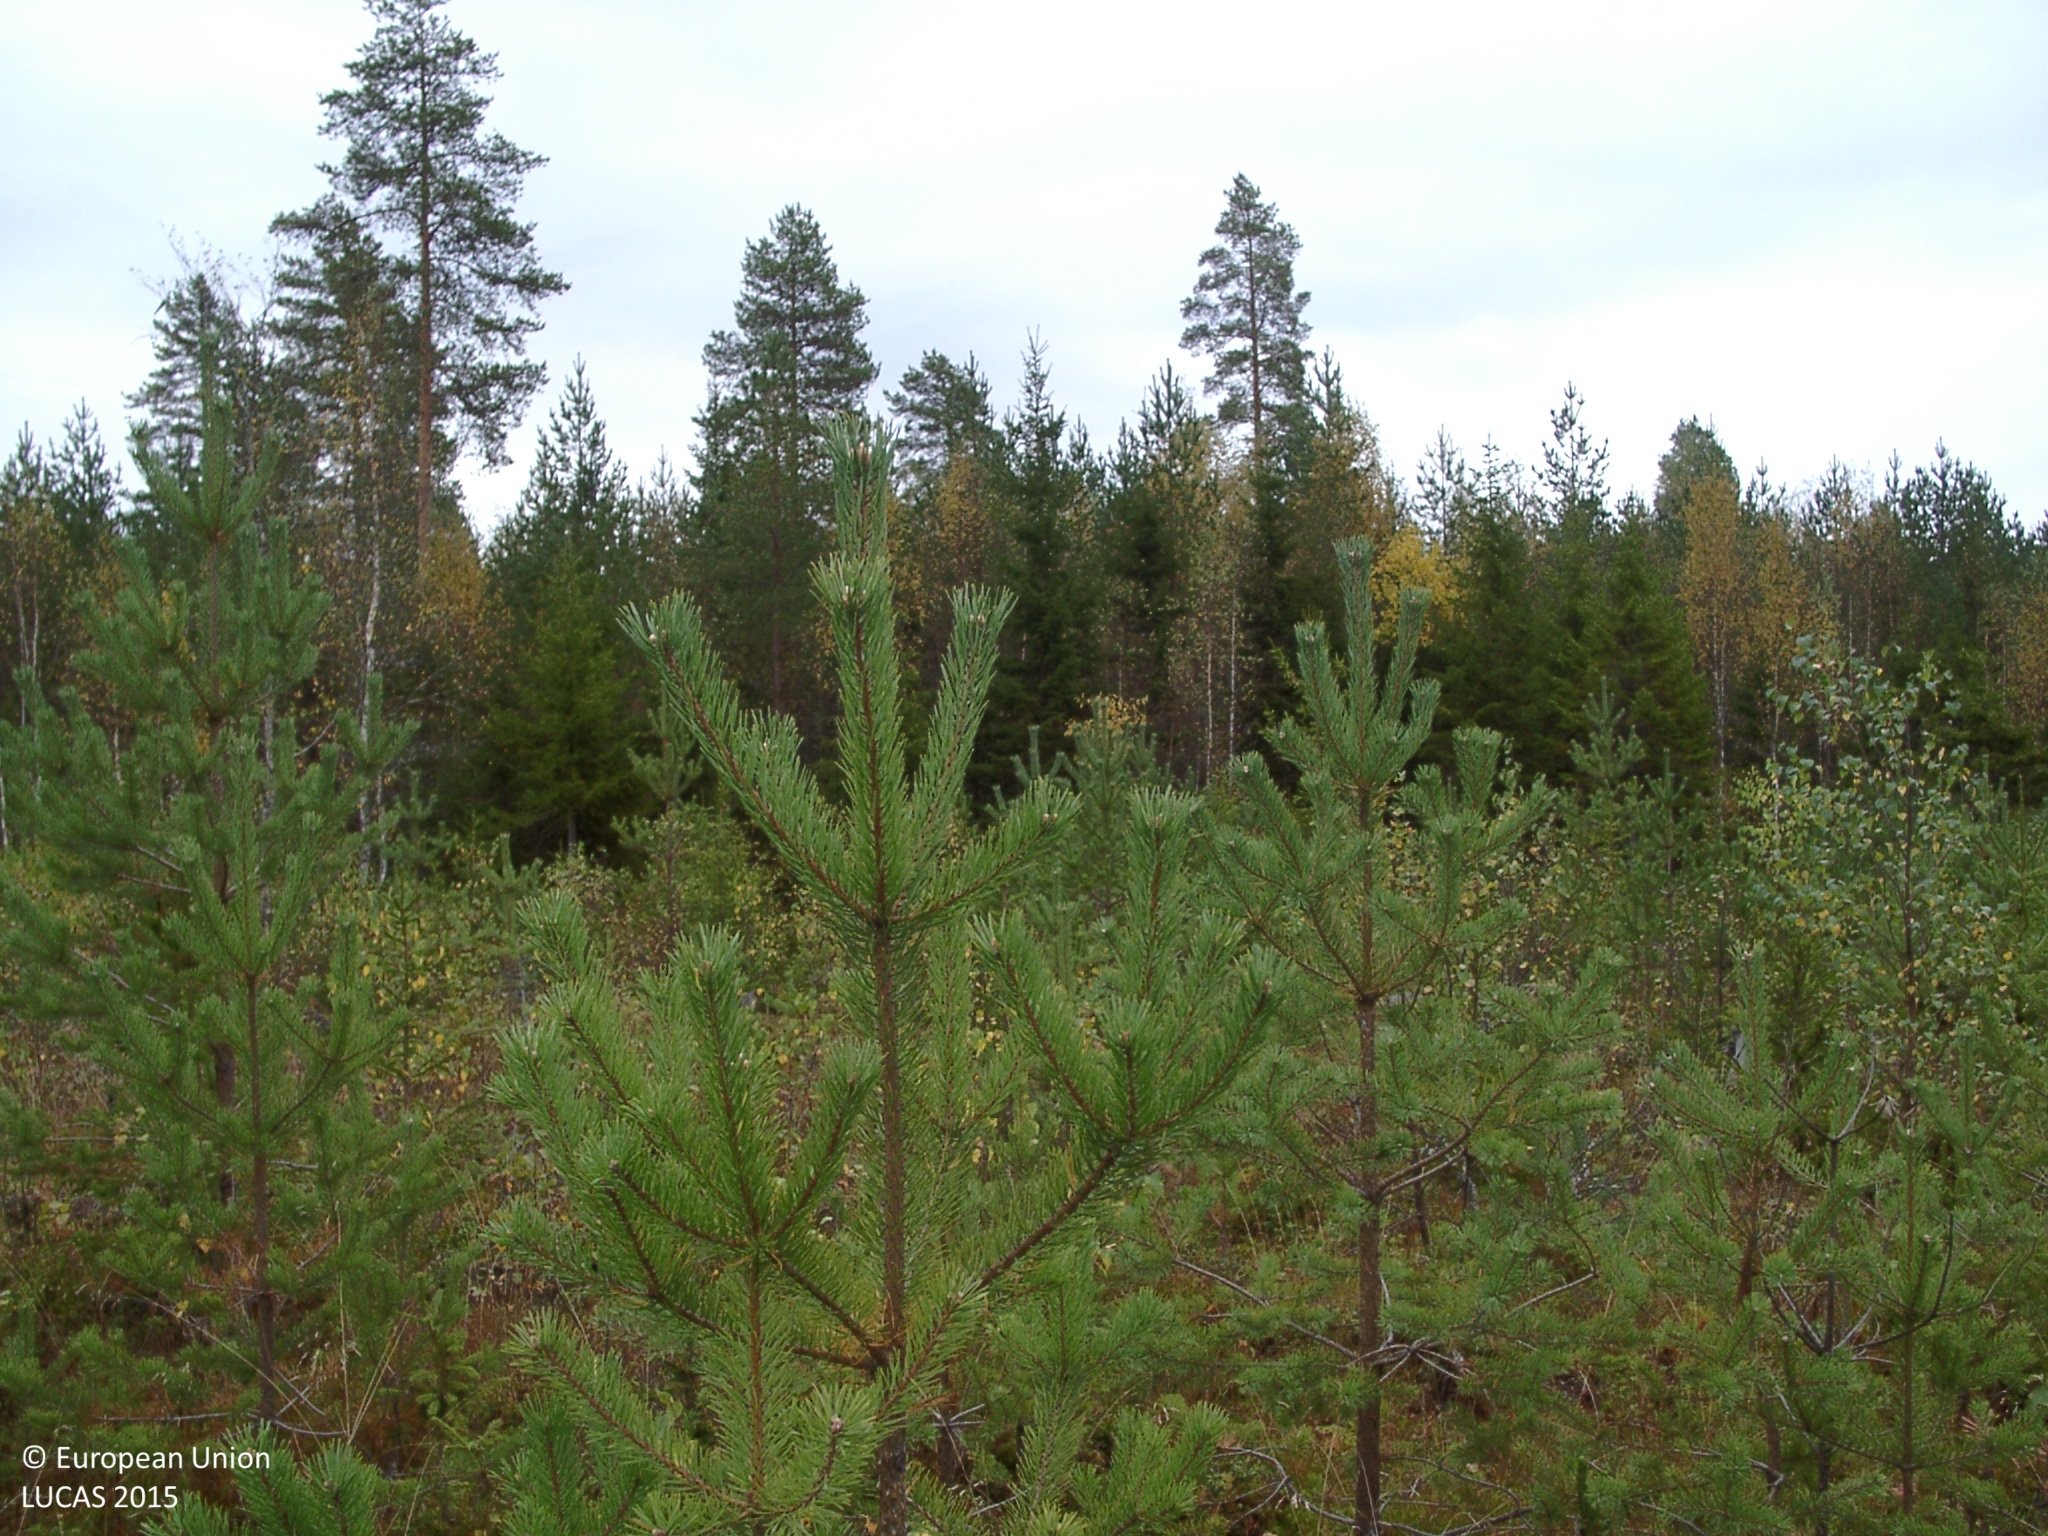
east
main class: Woodland
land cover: Pine dominated coniferous woodland
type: boreal forest
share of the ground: 10 - 25 %
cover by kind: lichens and mosses 30 %, shrubs 25 %, herbaceous plants 25 %, coniferous forest trees 20 %
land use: Forestry
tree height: < 5 m
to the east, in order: Pine dominated coniferous woodland; Other mixed woodland; Ditches and canals; Other mixed woodland; Ditches and canals; Other mixed woodland; Pine dominated mixed woodland; Ditches and canals; Pine dominated mixed woodland; Ditches and canals; Pine dominated mixed woodland; Ditches and canals; Pine dominated mixed woodland; Ditches and canals; Pine dominated mixed woodland; Ditches and canals; Pine dominated mixed woodland; Ditches and canals; Pine dominated mixed woodland; Ditches and canals; Pine dominated mixed woodland; Managed hedges; Grass margins; Paved roads, cycling and walking lanes; Shrubland without tree cover; Spruce dominated mixed woodland; Pine dominated coniferous woodland; Ditches and canals; Other coniferous woodland
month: September
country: FI
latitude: 62.8199
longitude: 25.4727
